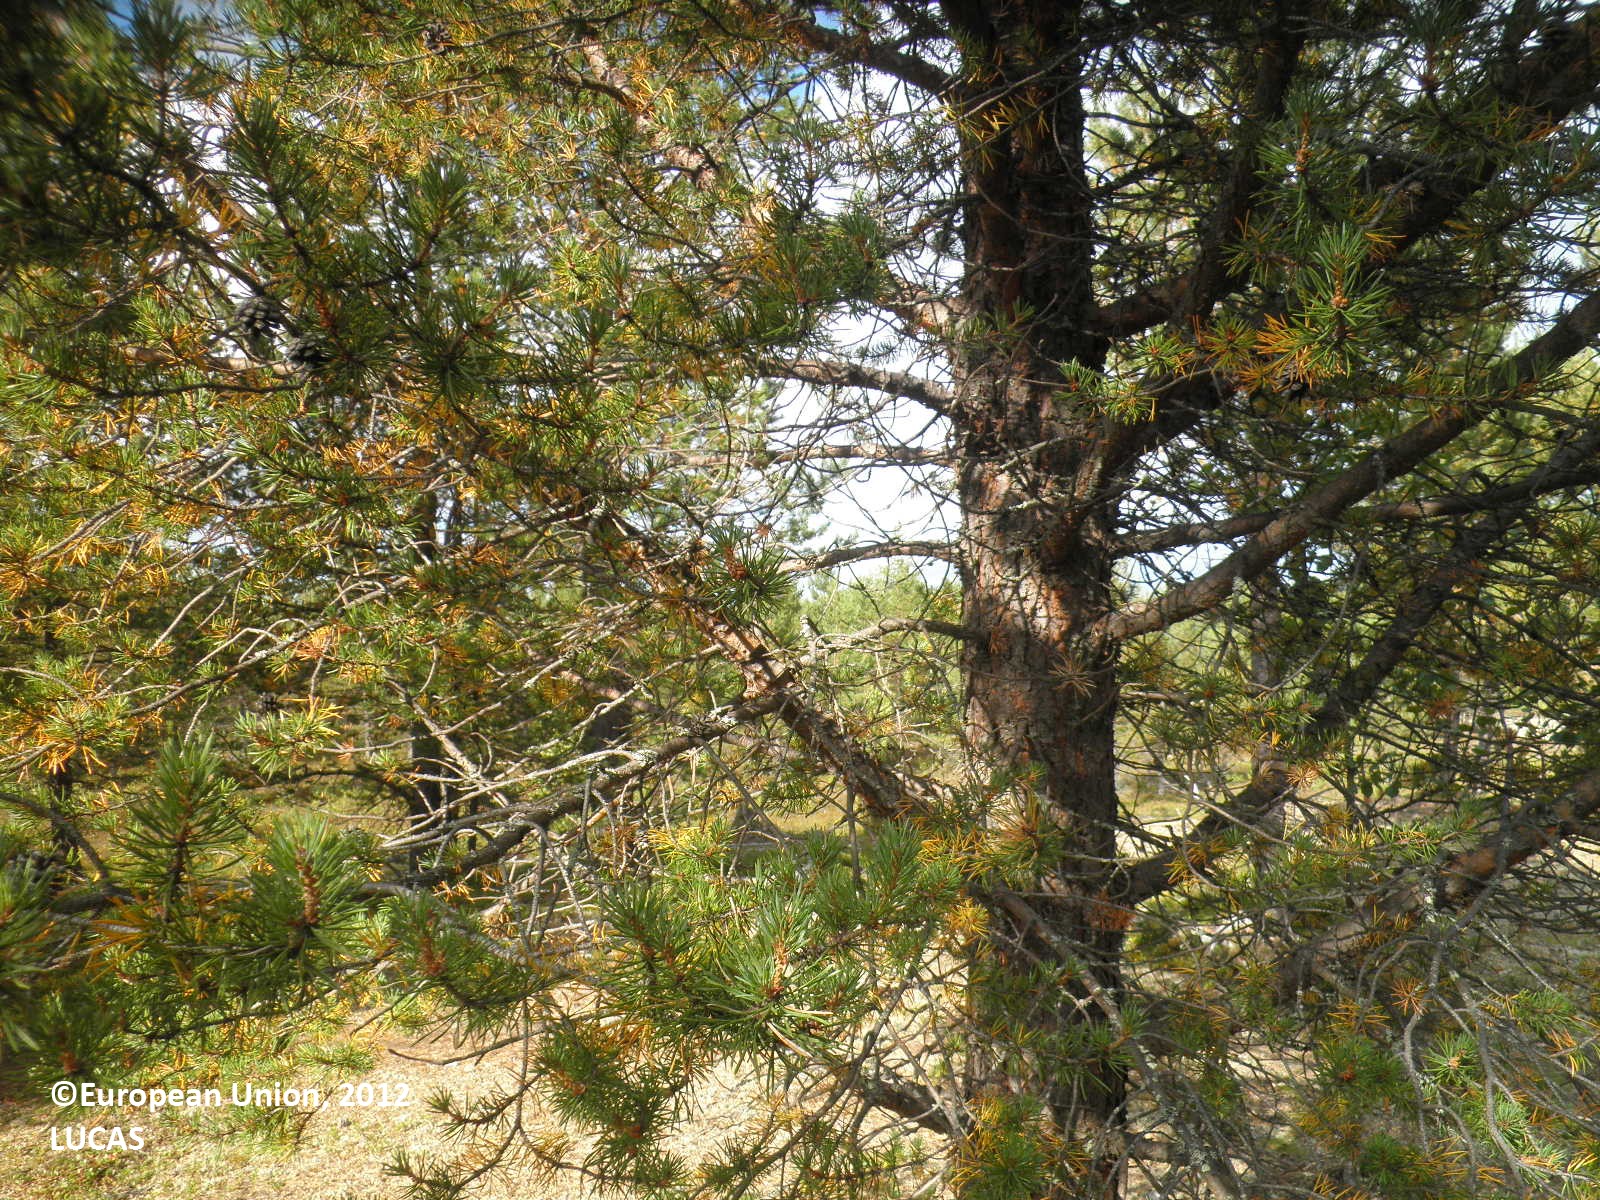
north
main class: Woodland
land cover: Pine dominated coniferous woodland
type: boreal forest
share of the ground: 25 - 50 %
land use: Forestry
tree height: > 5 m
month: August
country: FI
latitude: 67.5951
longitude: 29.9031
